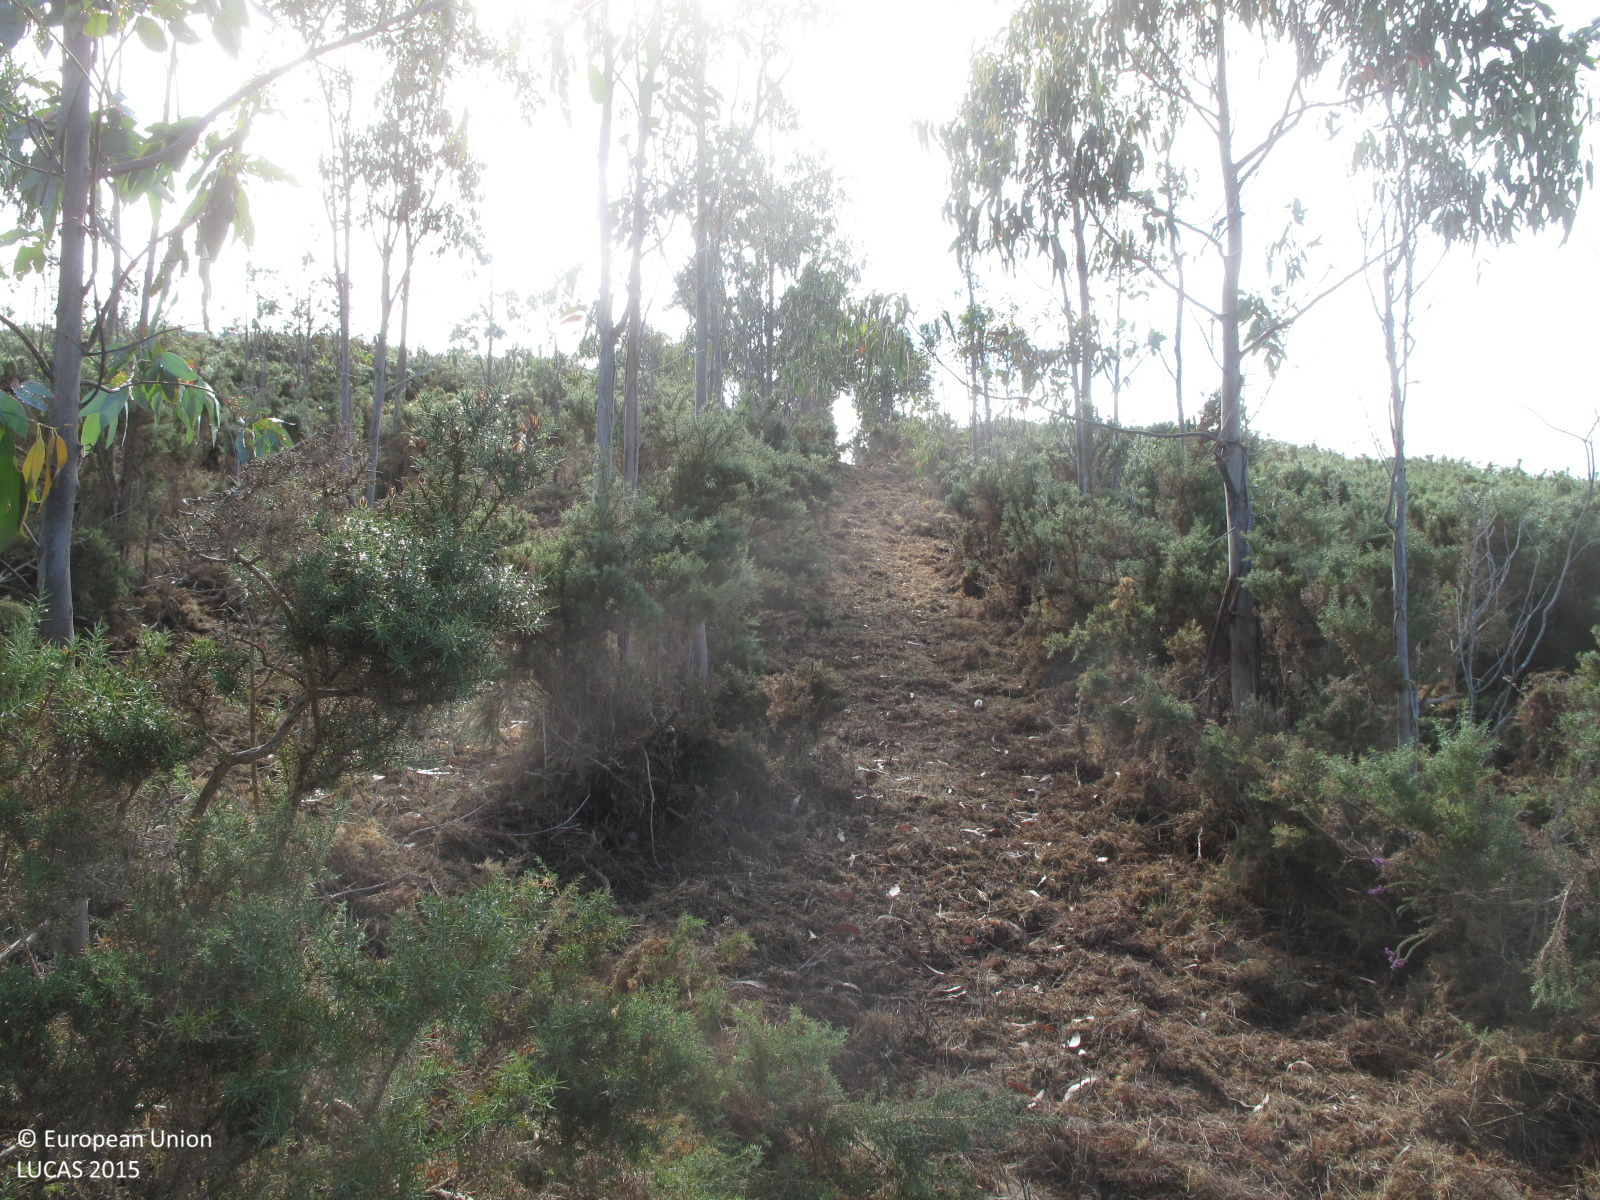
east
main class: Shrubland
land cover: Shrubland without tree cover
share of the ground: > 75 %
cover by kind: shrubs 100 %
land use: Abandoned areas
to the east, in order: Shrubland without tree cover; Broadleaved woodland; Tracks; Shrubland with sparse tree cover
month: July
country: ES
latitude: 43.0517
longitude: -9.1184
